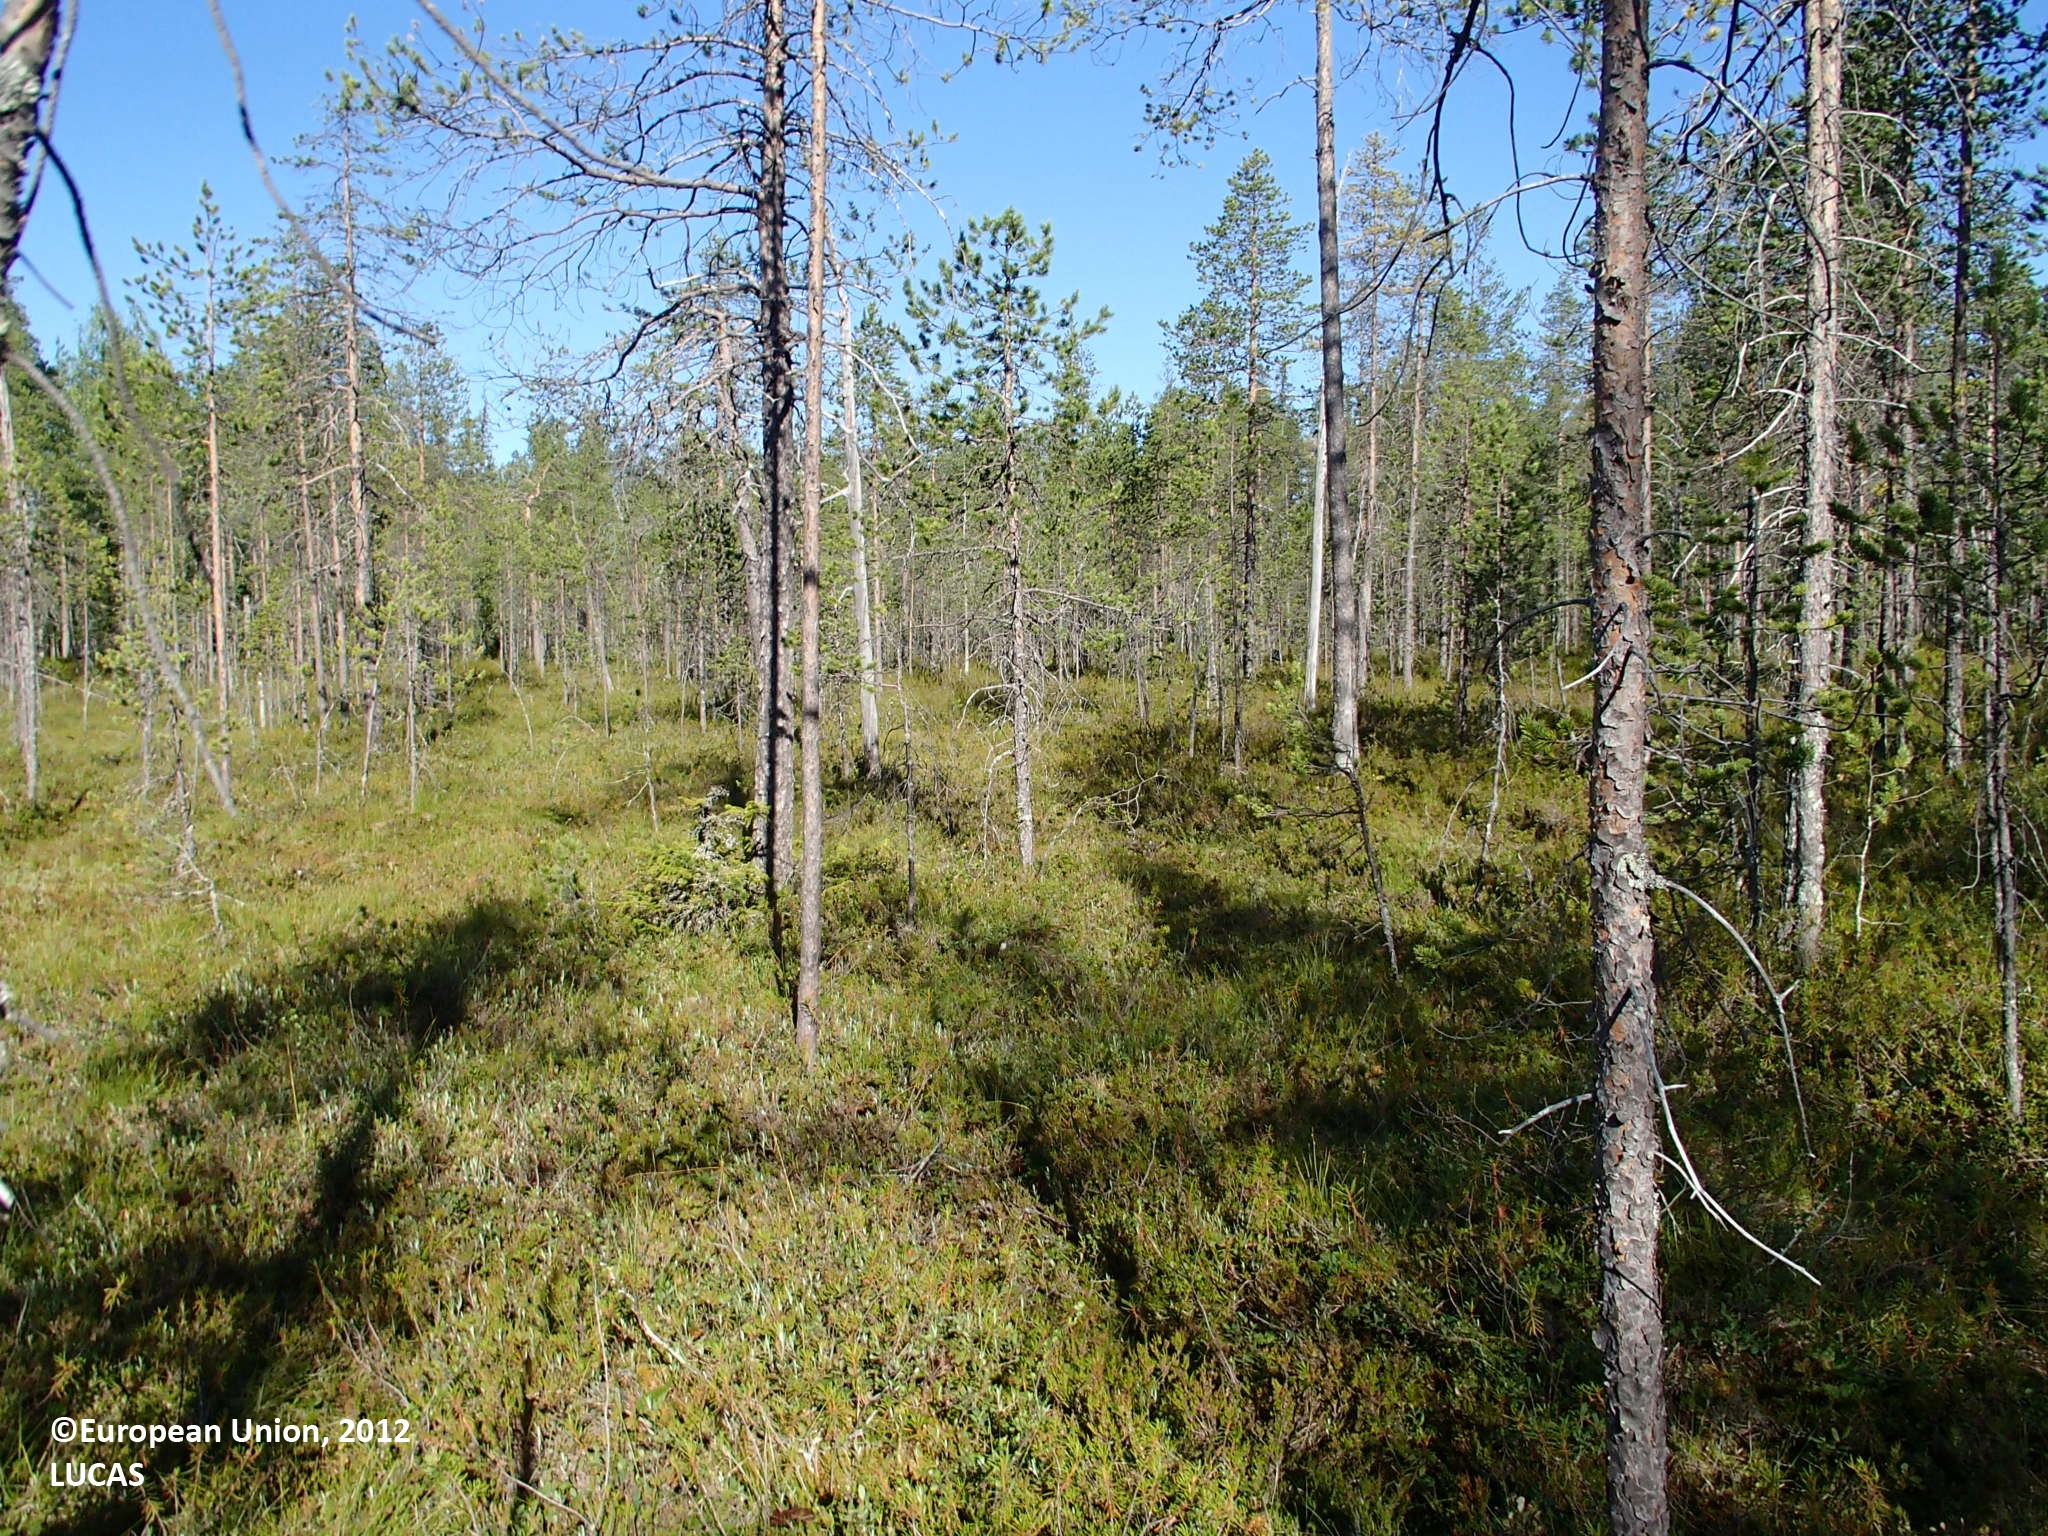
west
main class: Woodland
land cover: Pine dominated coniferous woodland
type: boreal forest
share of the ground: 10 - 25 %
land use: Forestry
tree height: > 5 m
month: July
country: FI
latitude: 66.8268
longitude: 25.5688
